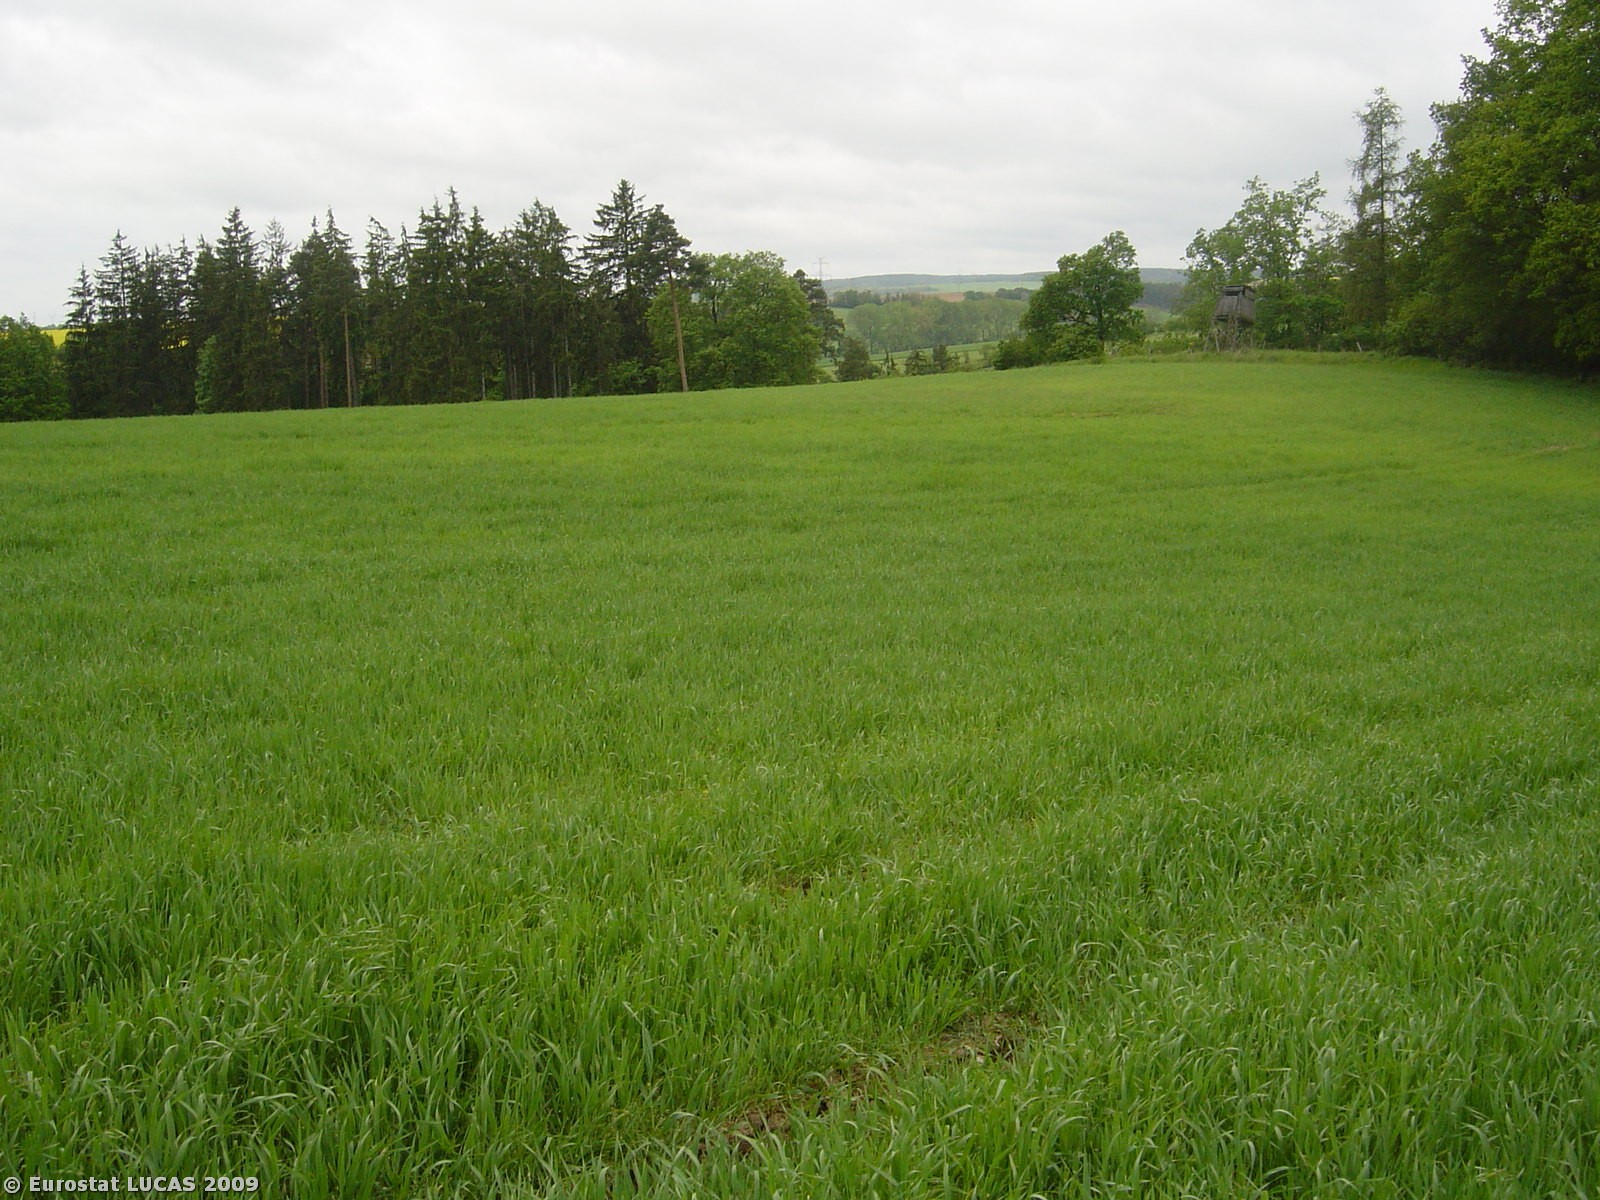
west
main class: Cropland
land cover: Barley
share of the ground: > 75 %
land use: Agriculture (excluding fallow land and kitchen gardens)
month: May
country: CZ
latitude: 49.2439
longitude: 16.4490
